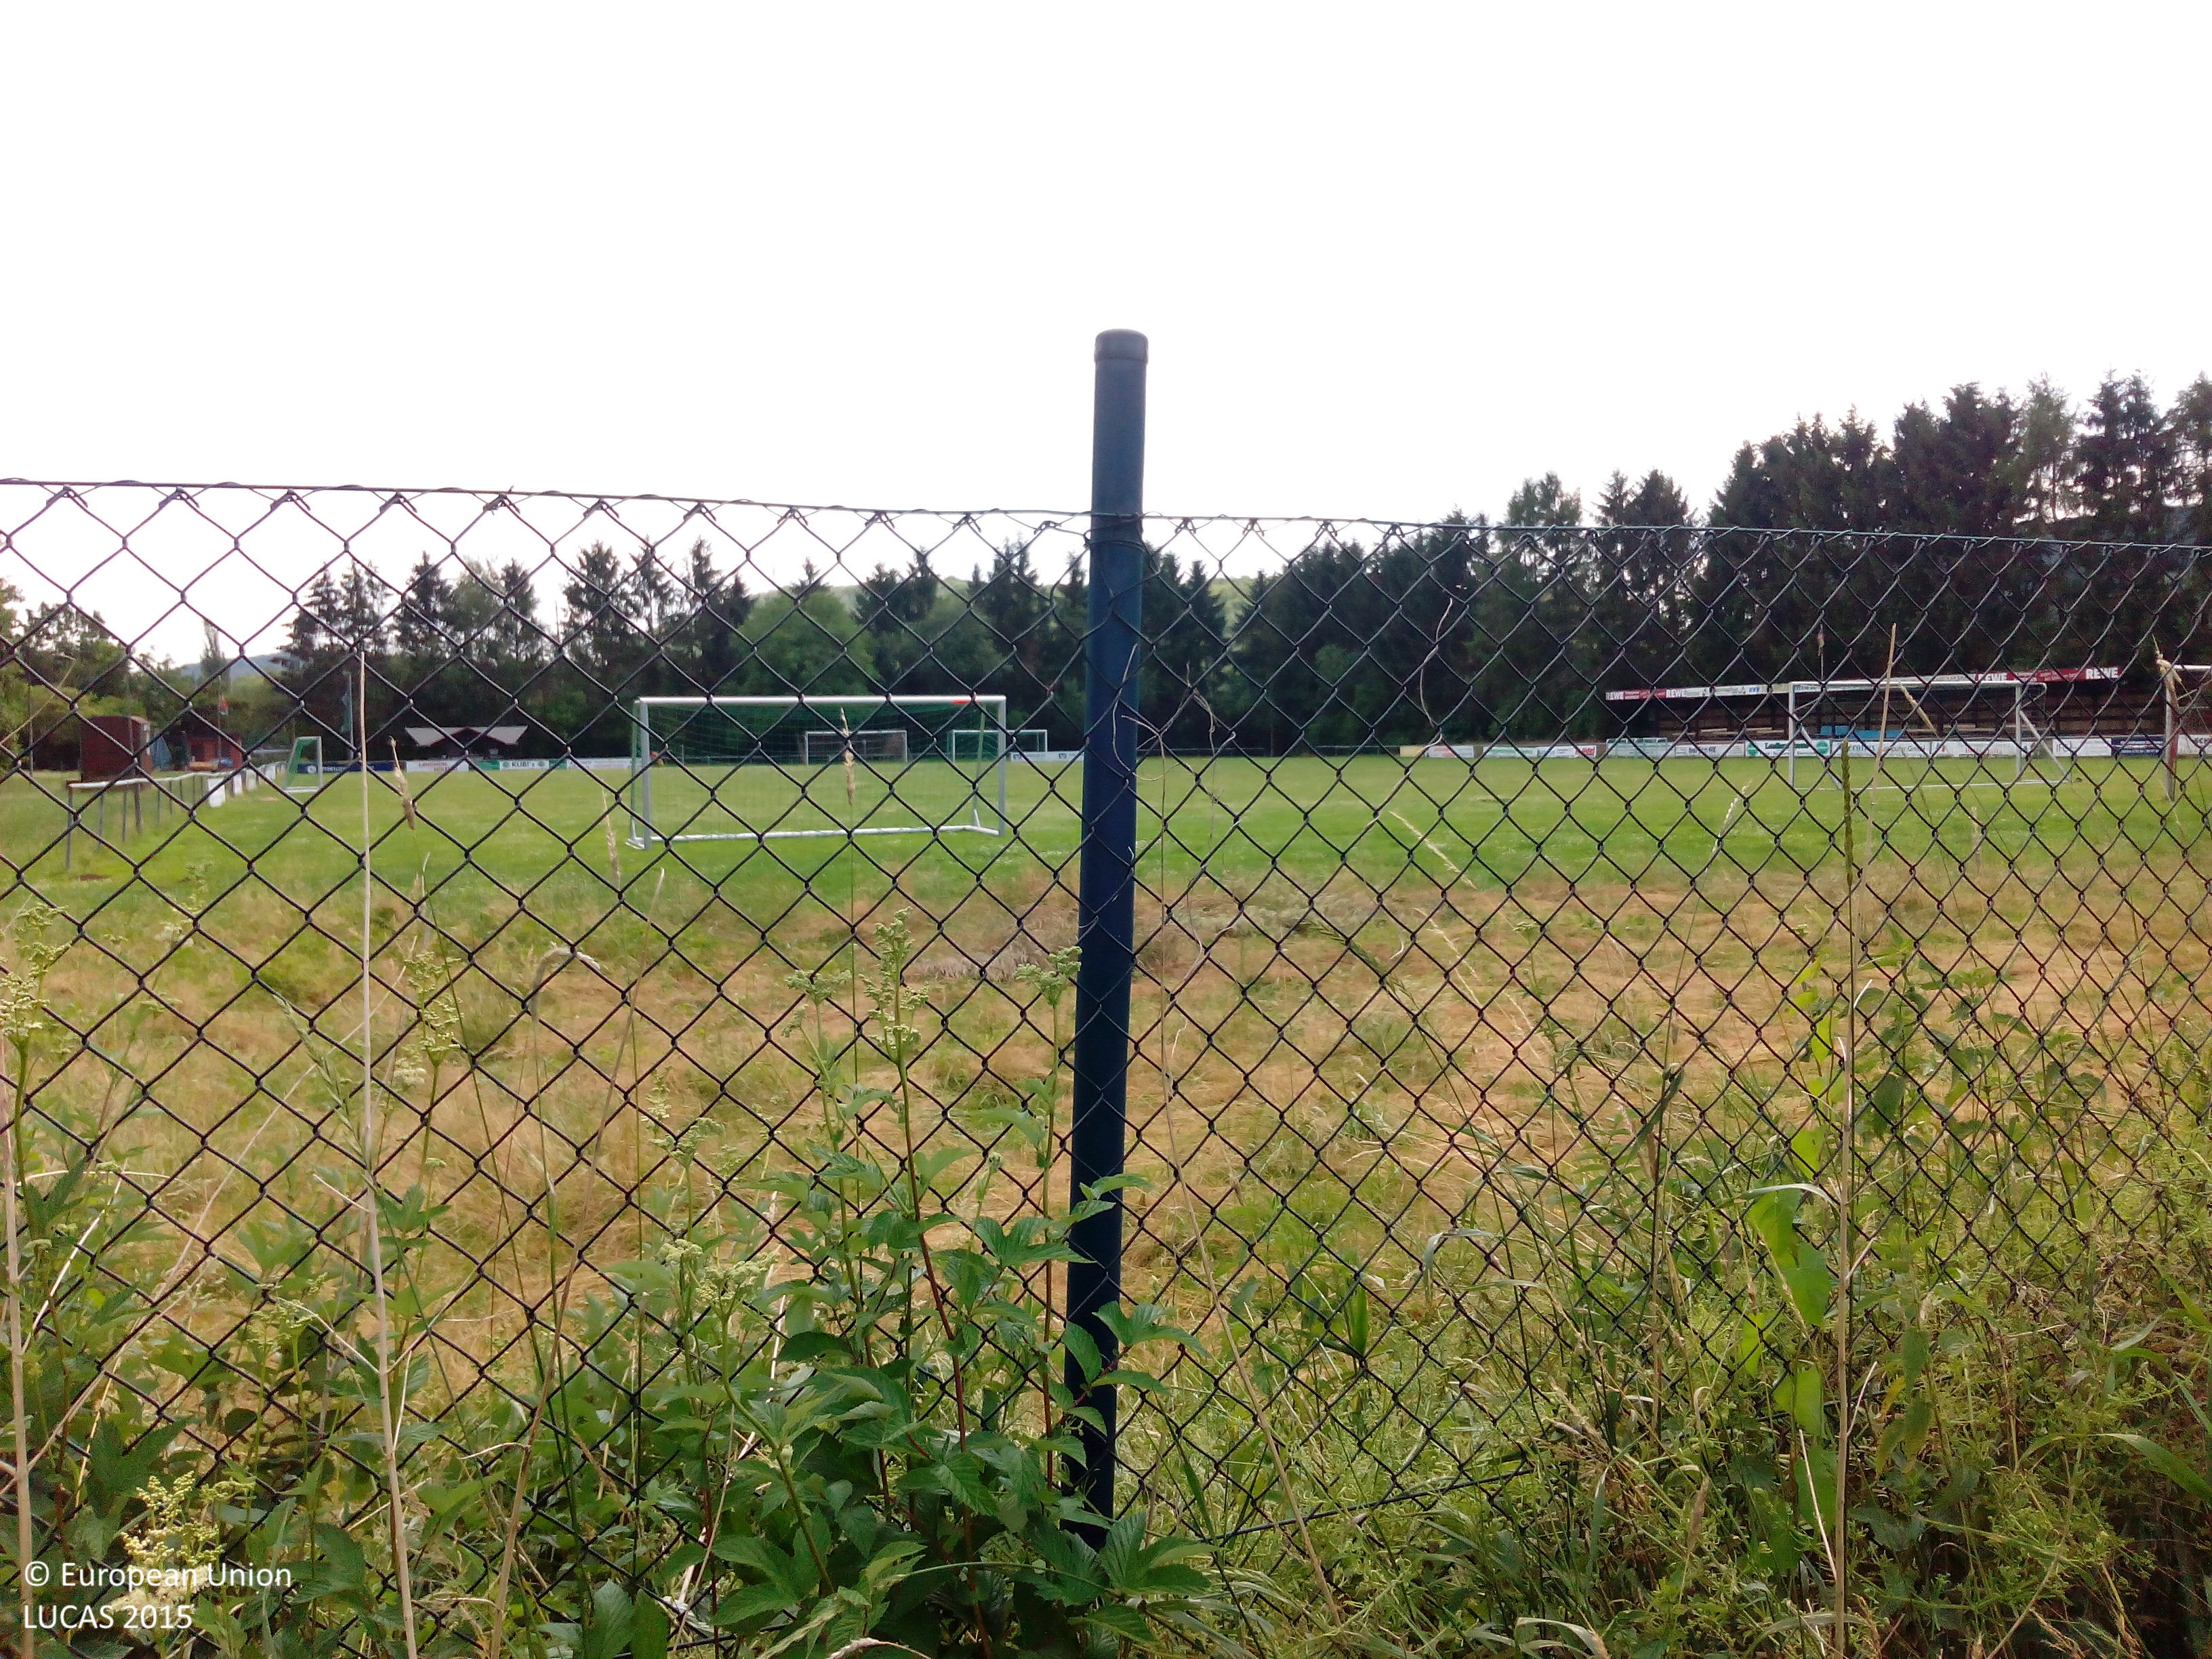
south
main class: Grassland
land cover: Grassland without tree/shrub cover
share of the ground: > 75 %
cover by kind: herbaceous plants 100 %
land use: Sport
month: July
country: DE
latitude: 51.8562
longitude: 9.9565
